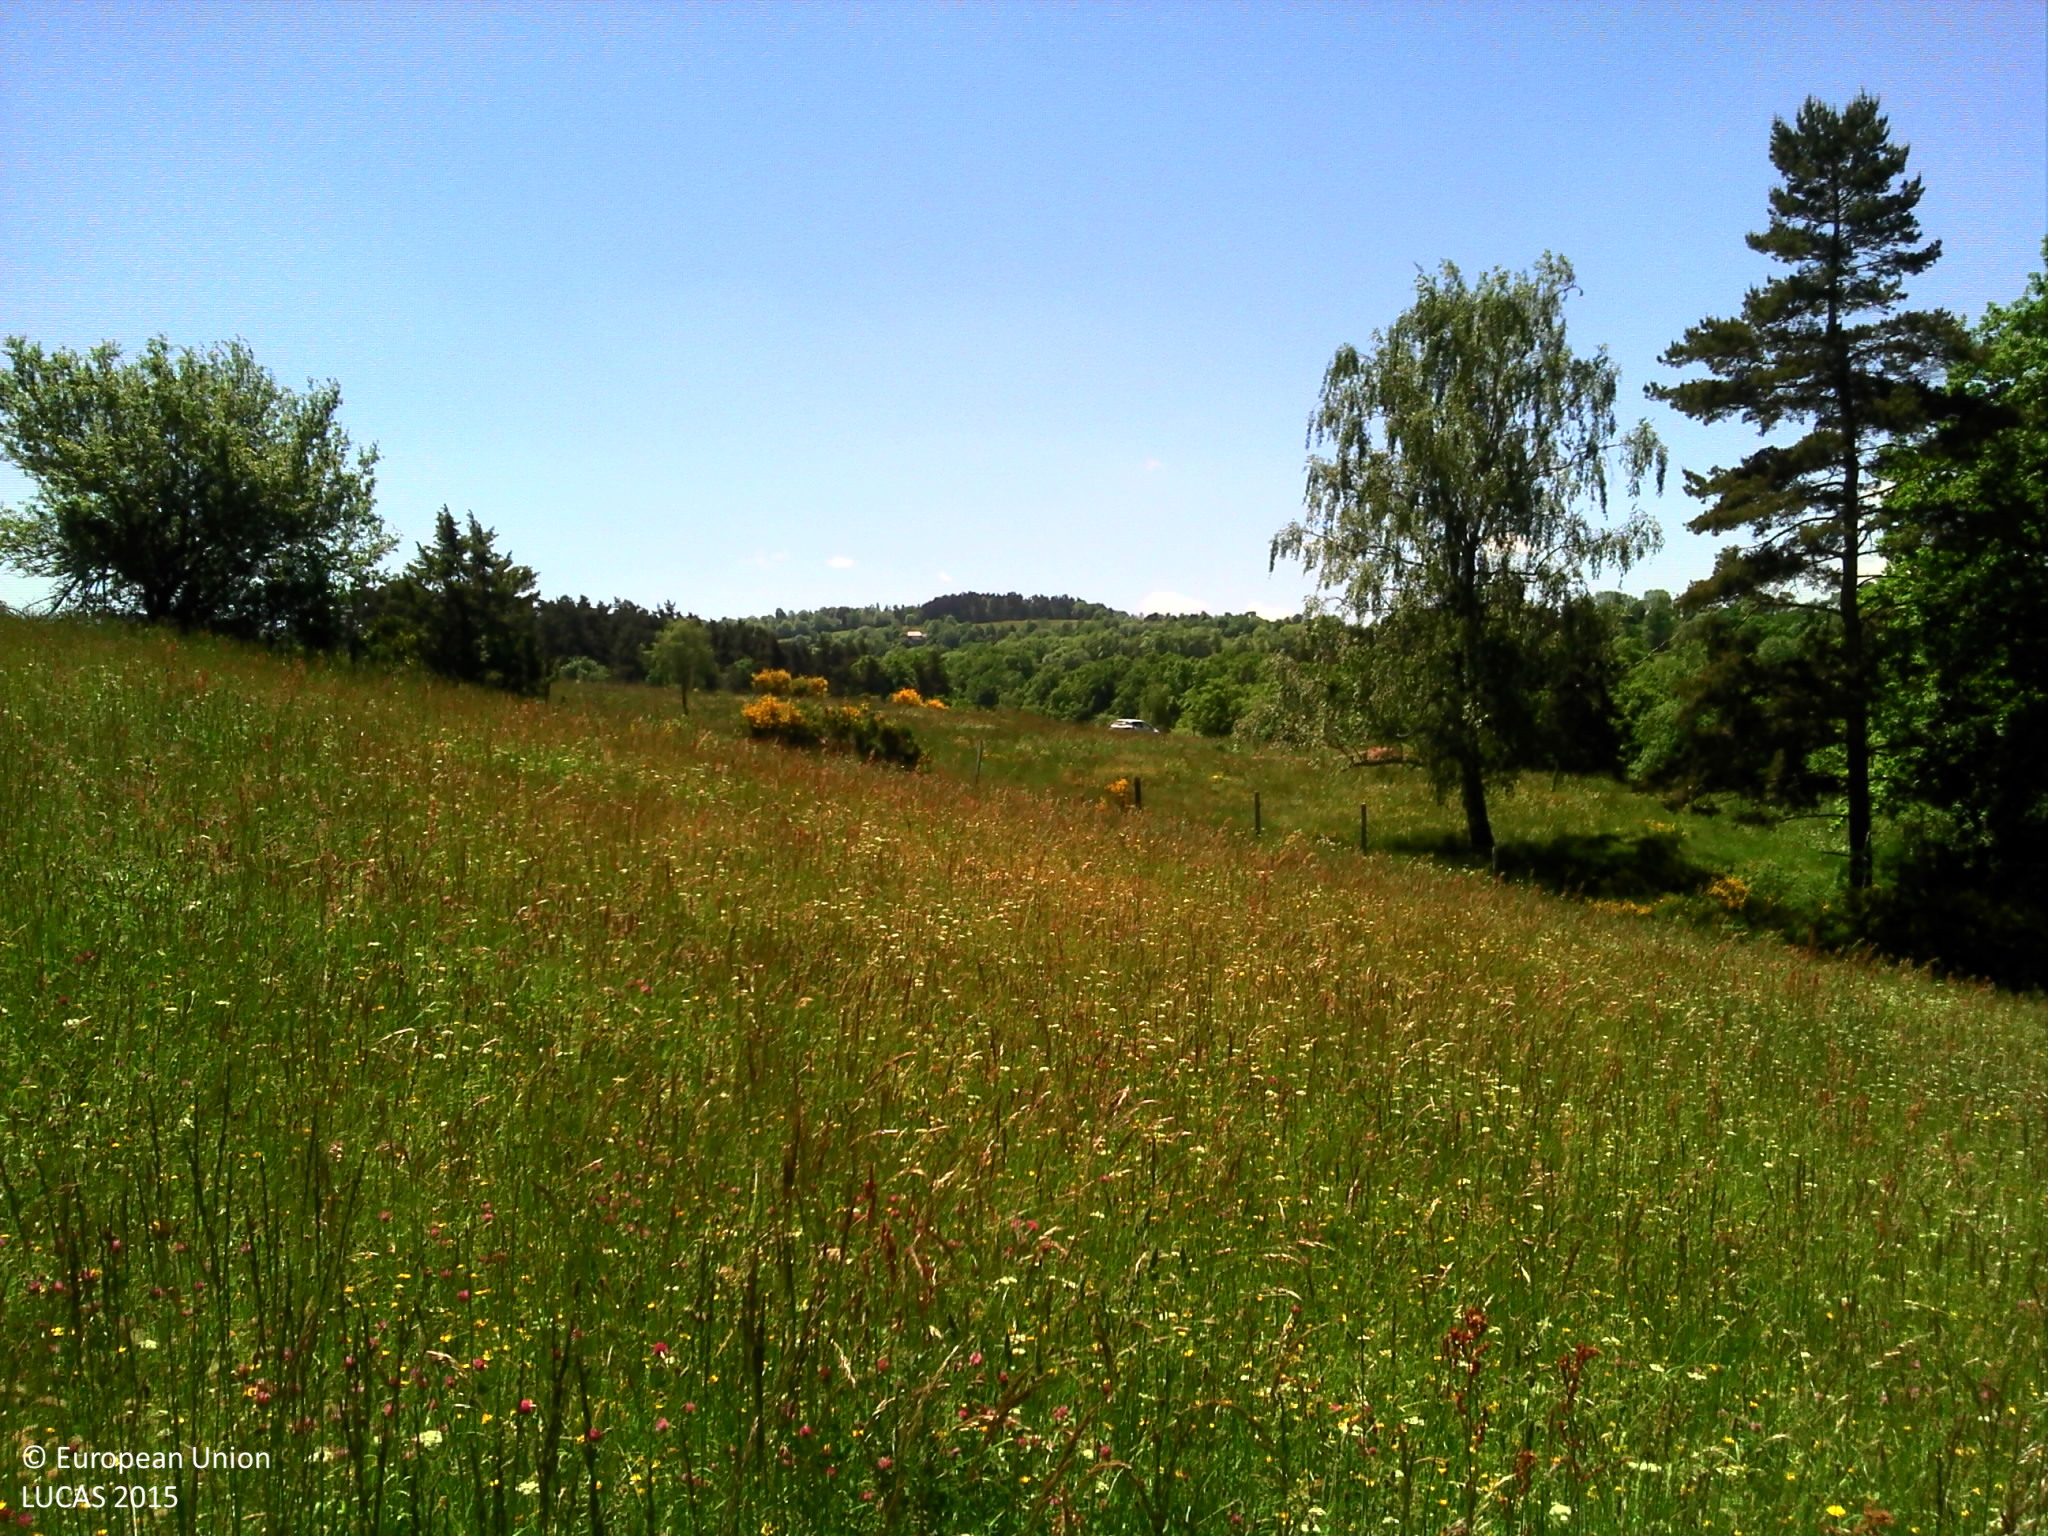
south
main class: Grassland
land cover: Grassland without tree/shrub cover
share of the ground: > 75 %
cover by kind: herbaceous plants 100 %
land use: Agriculture (excluding fallow land and kitchen gardens)
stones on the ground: < 10 %
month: June
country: FR
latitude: 44.9560
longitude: 3.1449
